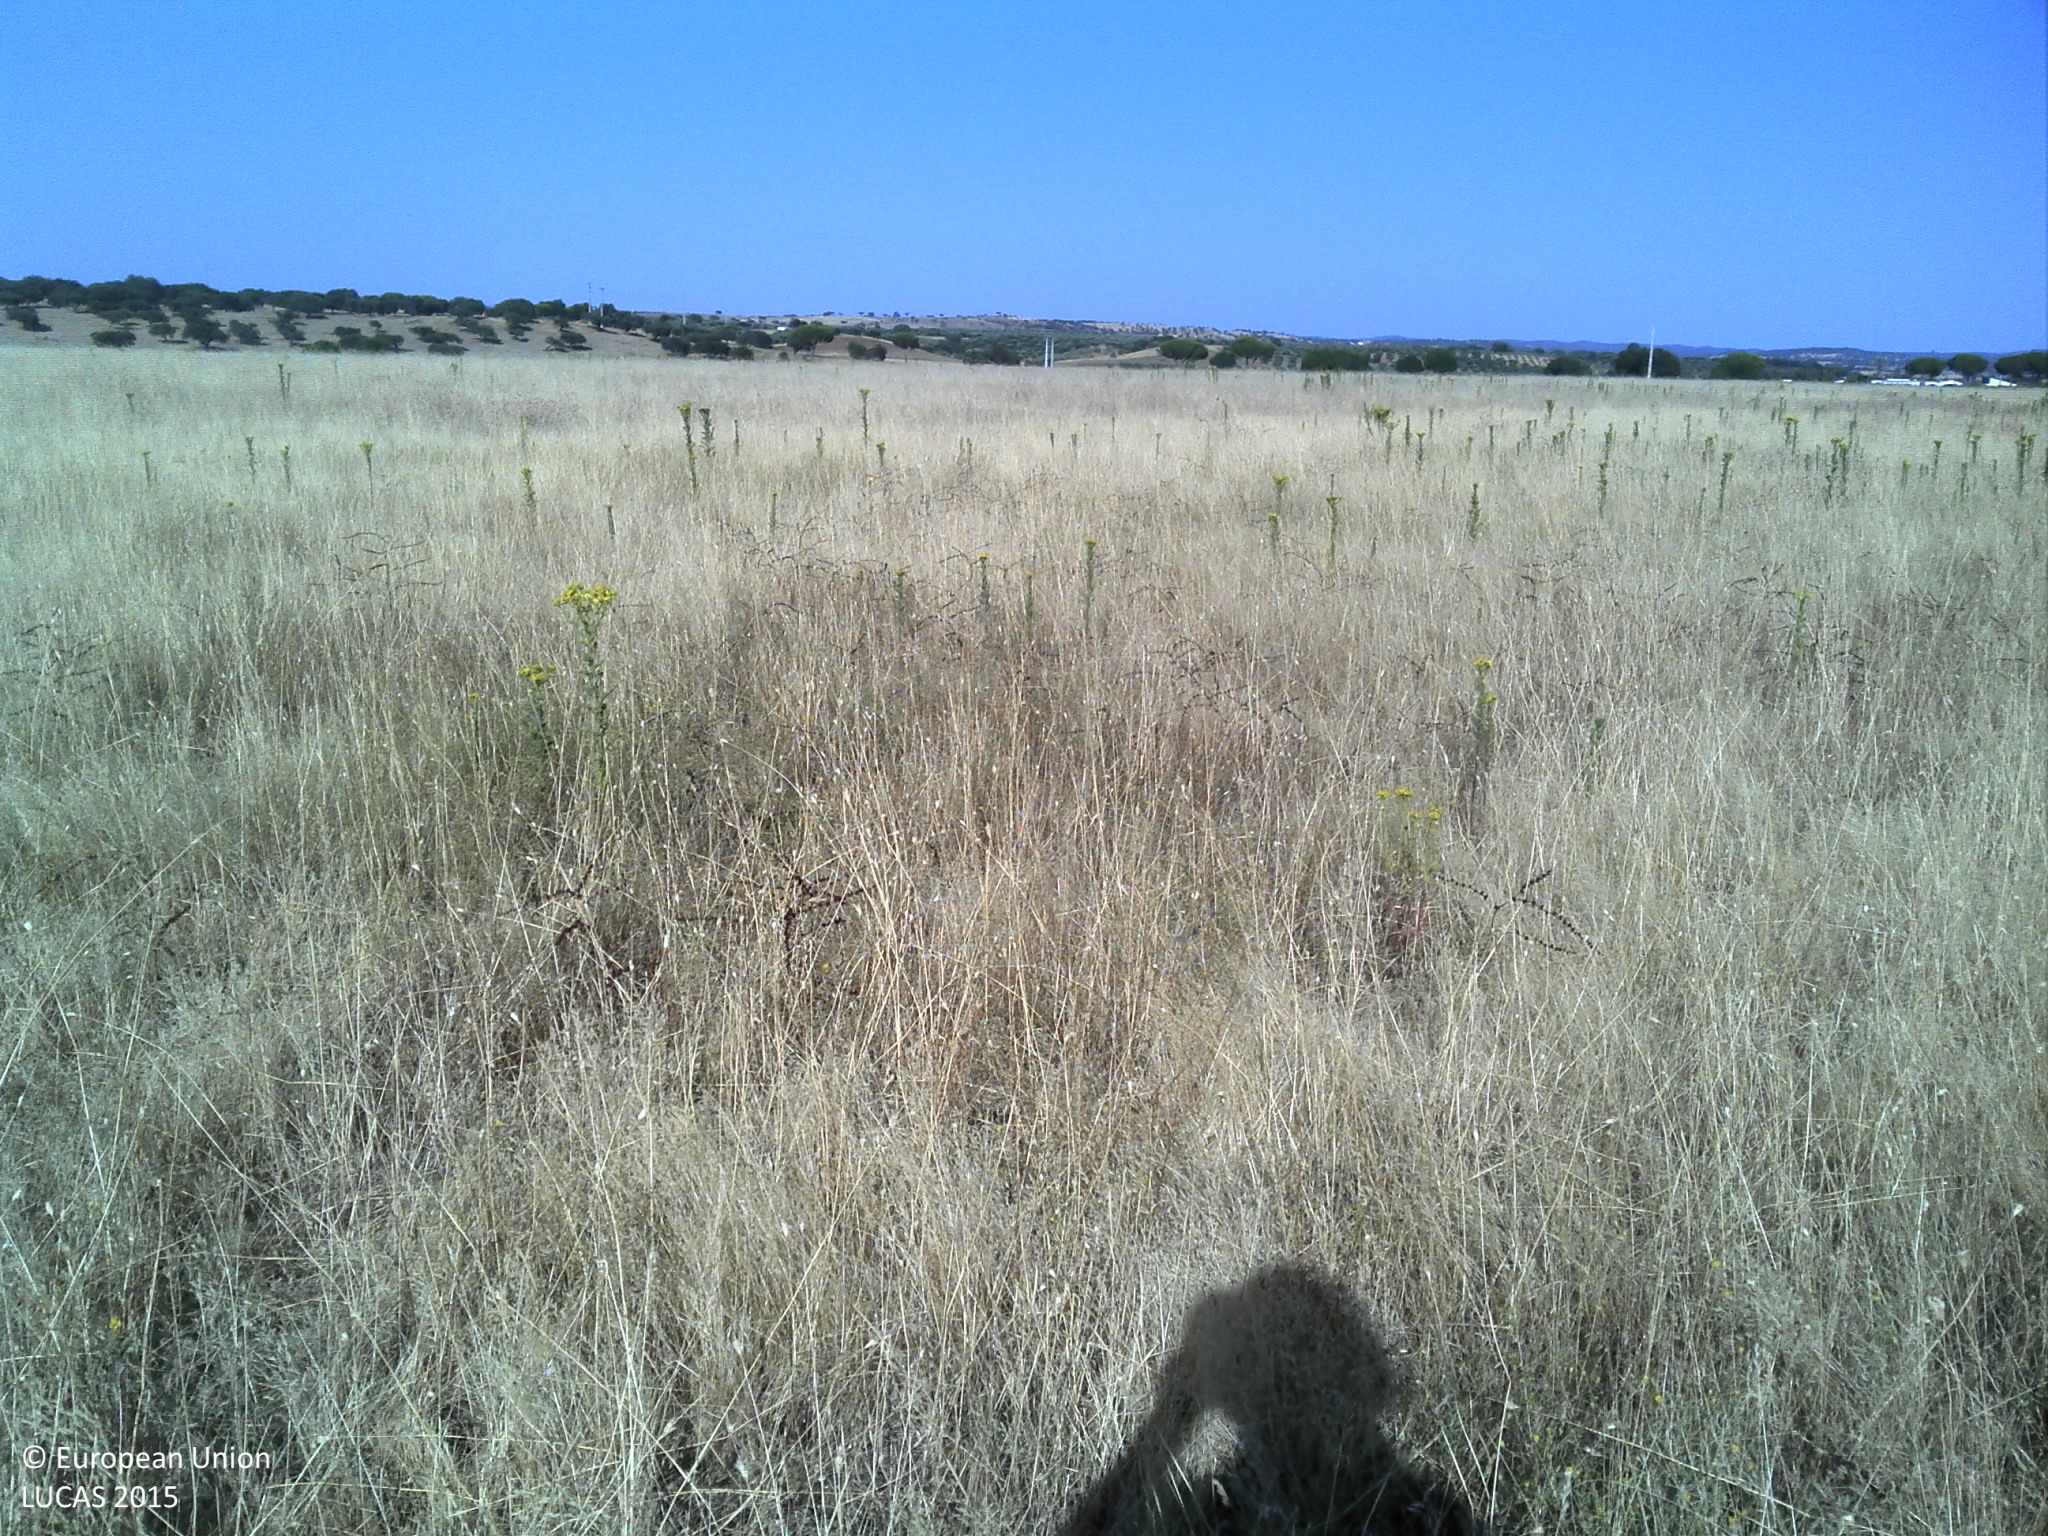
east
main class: Grassland
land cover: Grassland without tree/shrub cover
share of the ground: > 75 %
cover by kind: herbaceous plants 100 %
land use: Agriculture (excluding fallow land and kitchen gardens)
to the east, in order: Grassland without tree/shrub cover
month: June
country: PT
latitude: 38.0600
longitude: -7.2591
